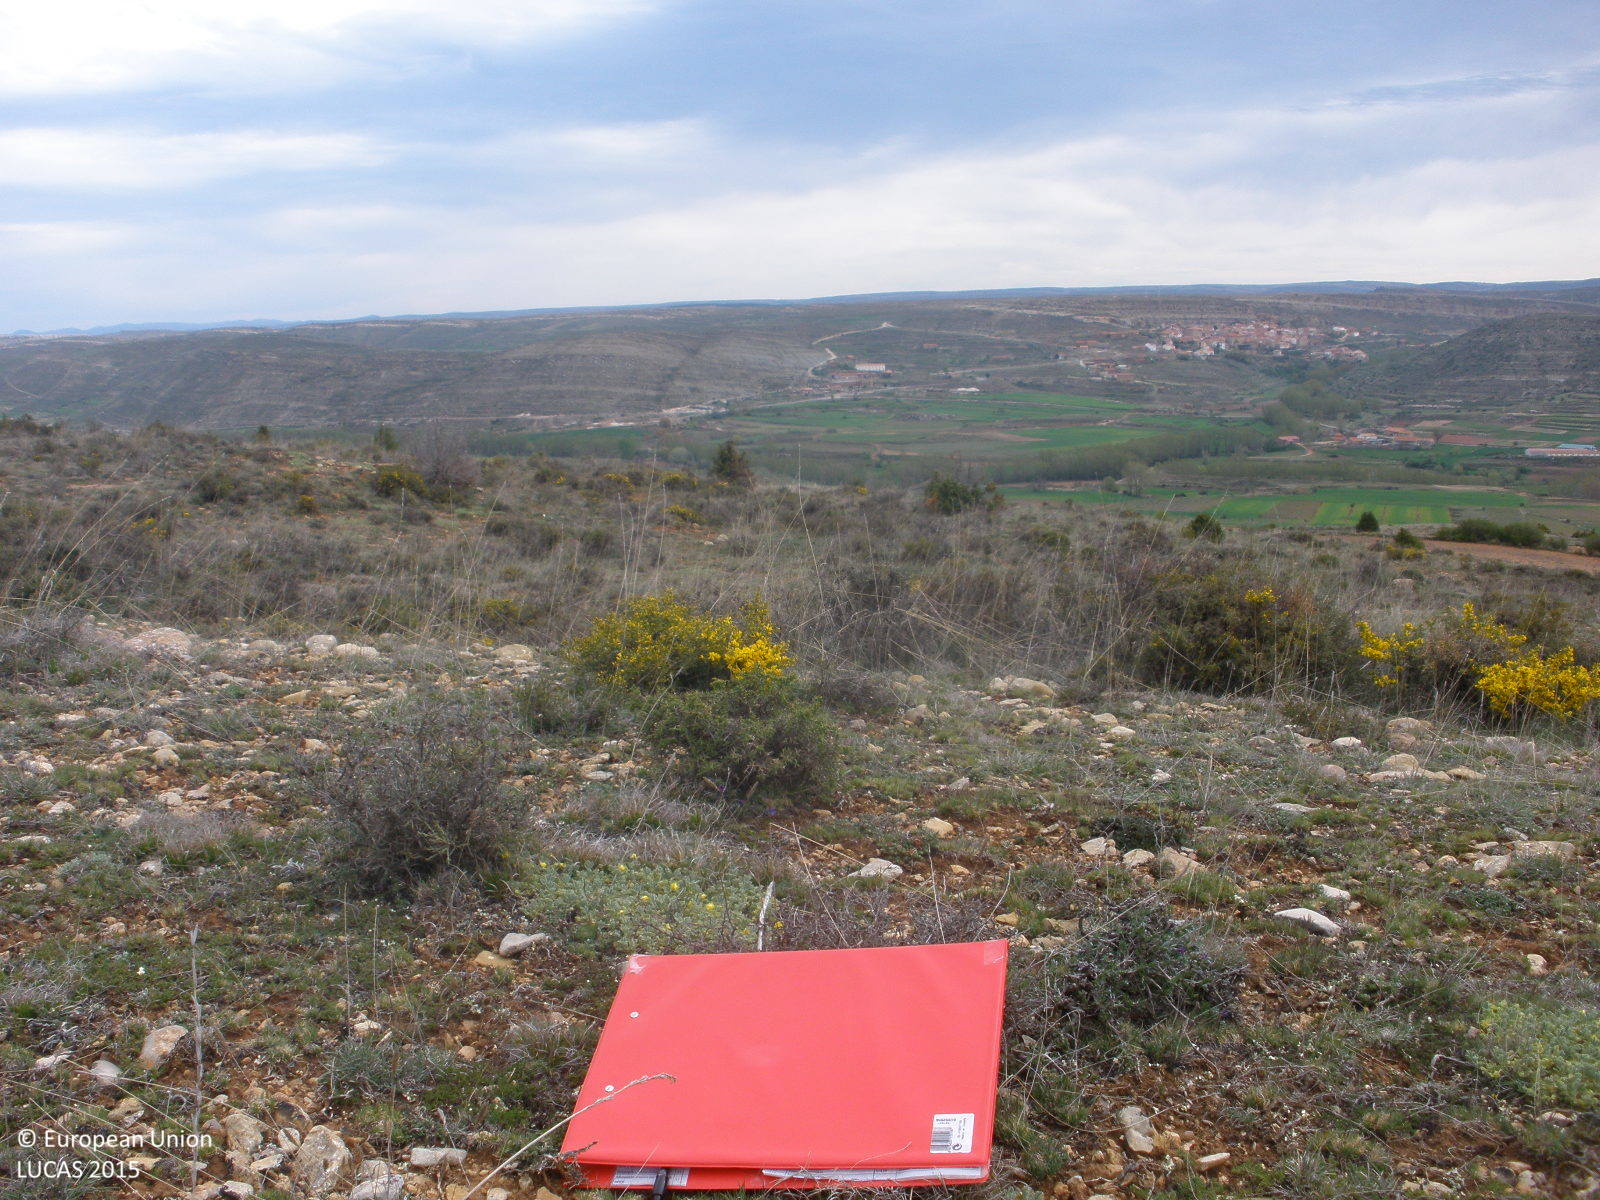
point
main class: Shrubland
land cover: Shrubland without tree cover
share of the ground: 25 - 50 %
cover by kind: herbaceous plants 50 %, shrubs 40 %, consolidated bare surface 10 %
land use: Semi-natural and natural areas not in use
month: May
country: ES
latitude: 40.4766
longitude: -0.7555
